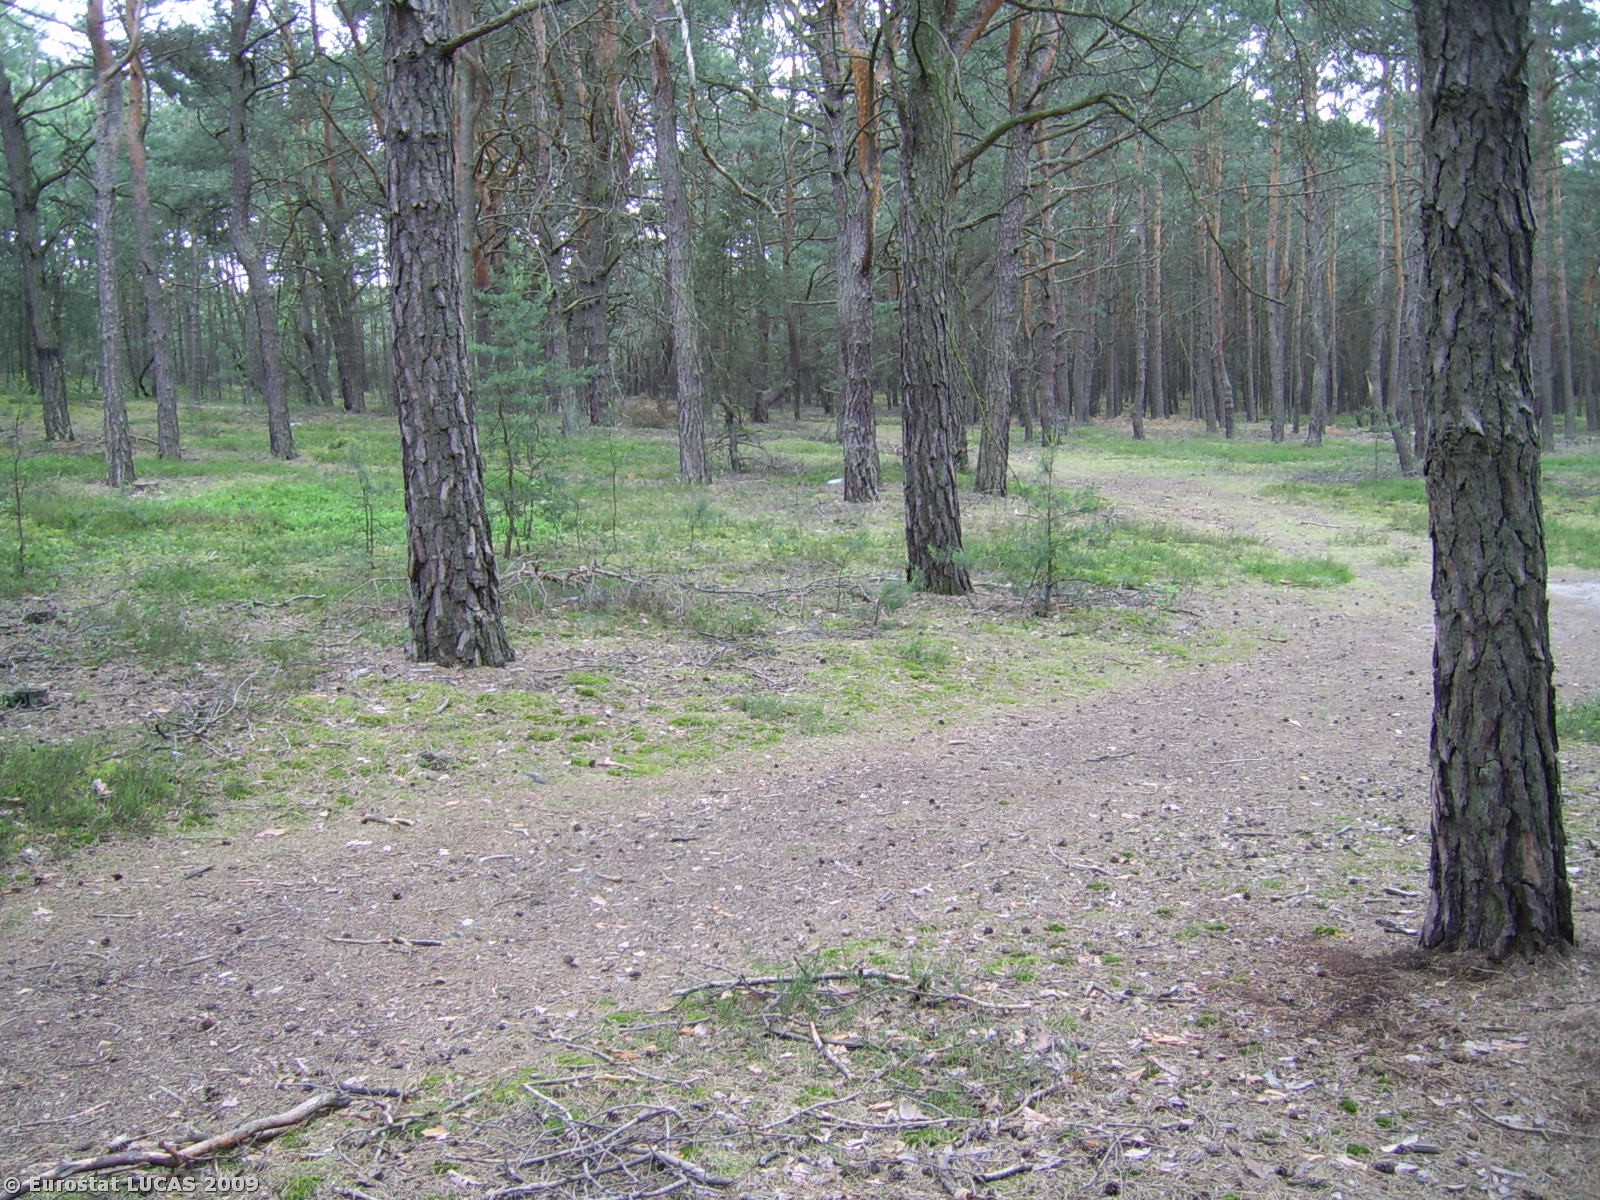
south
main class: Woodland
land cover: Coniferous woodland
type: hemiboreal forest and nemoral coniferous forest and mixed broadleaved-coniferous forest
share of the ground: 50 - 75 %
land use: Forestry
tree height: > 5 m
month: June
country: PL
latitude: 52.0493
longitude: 17.7865
